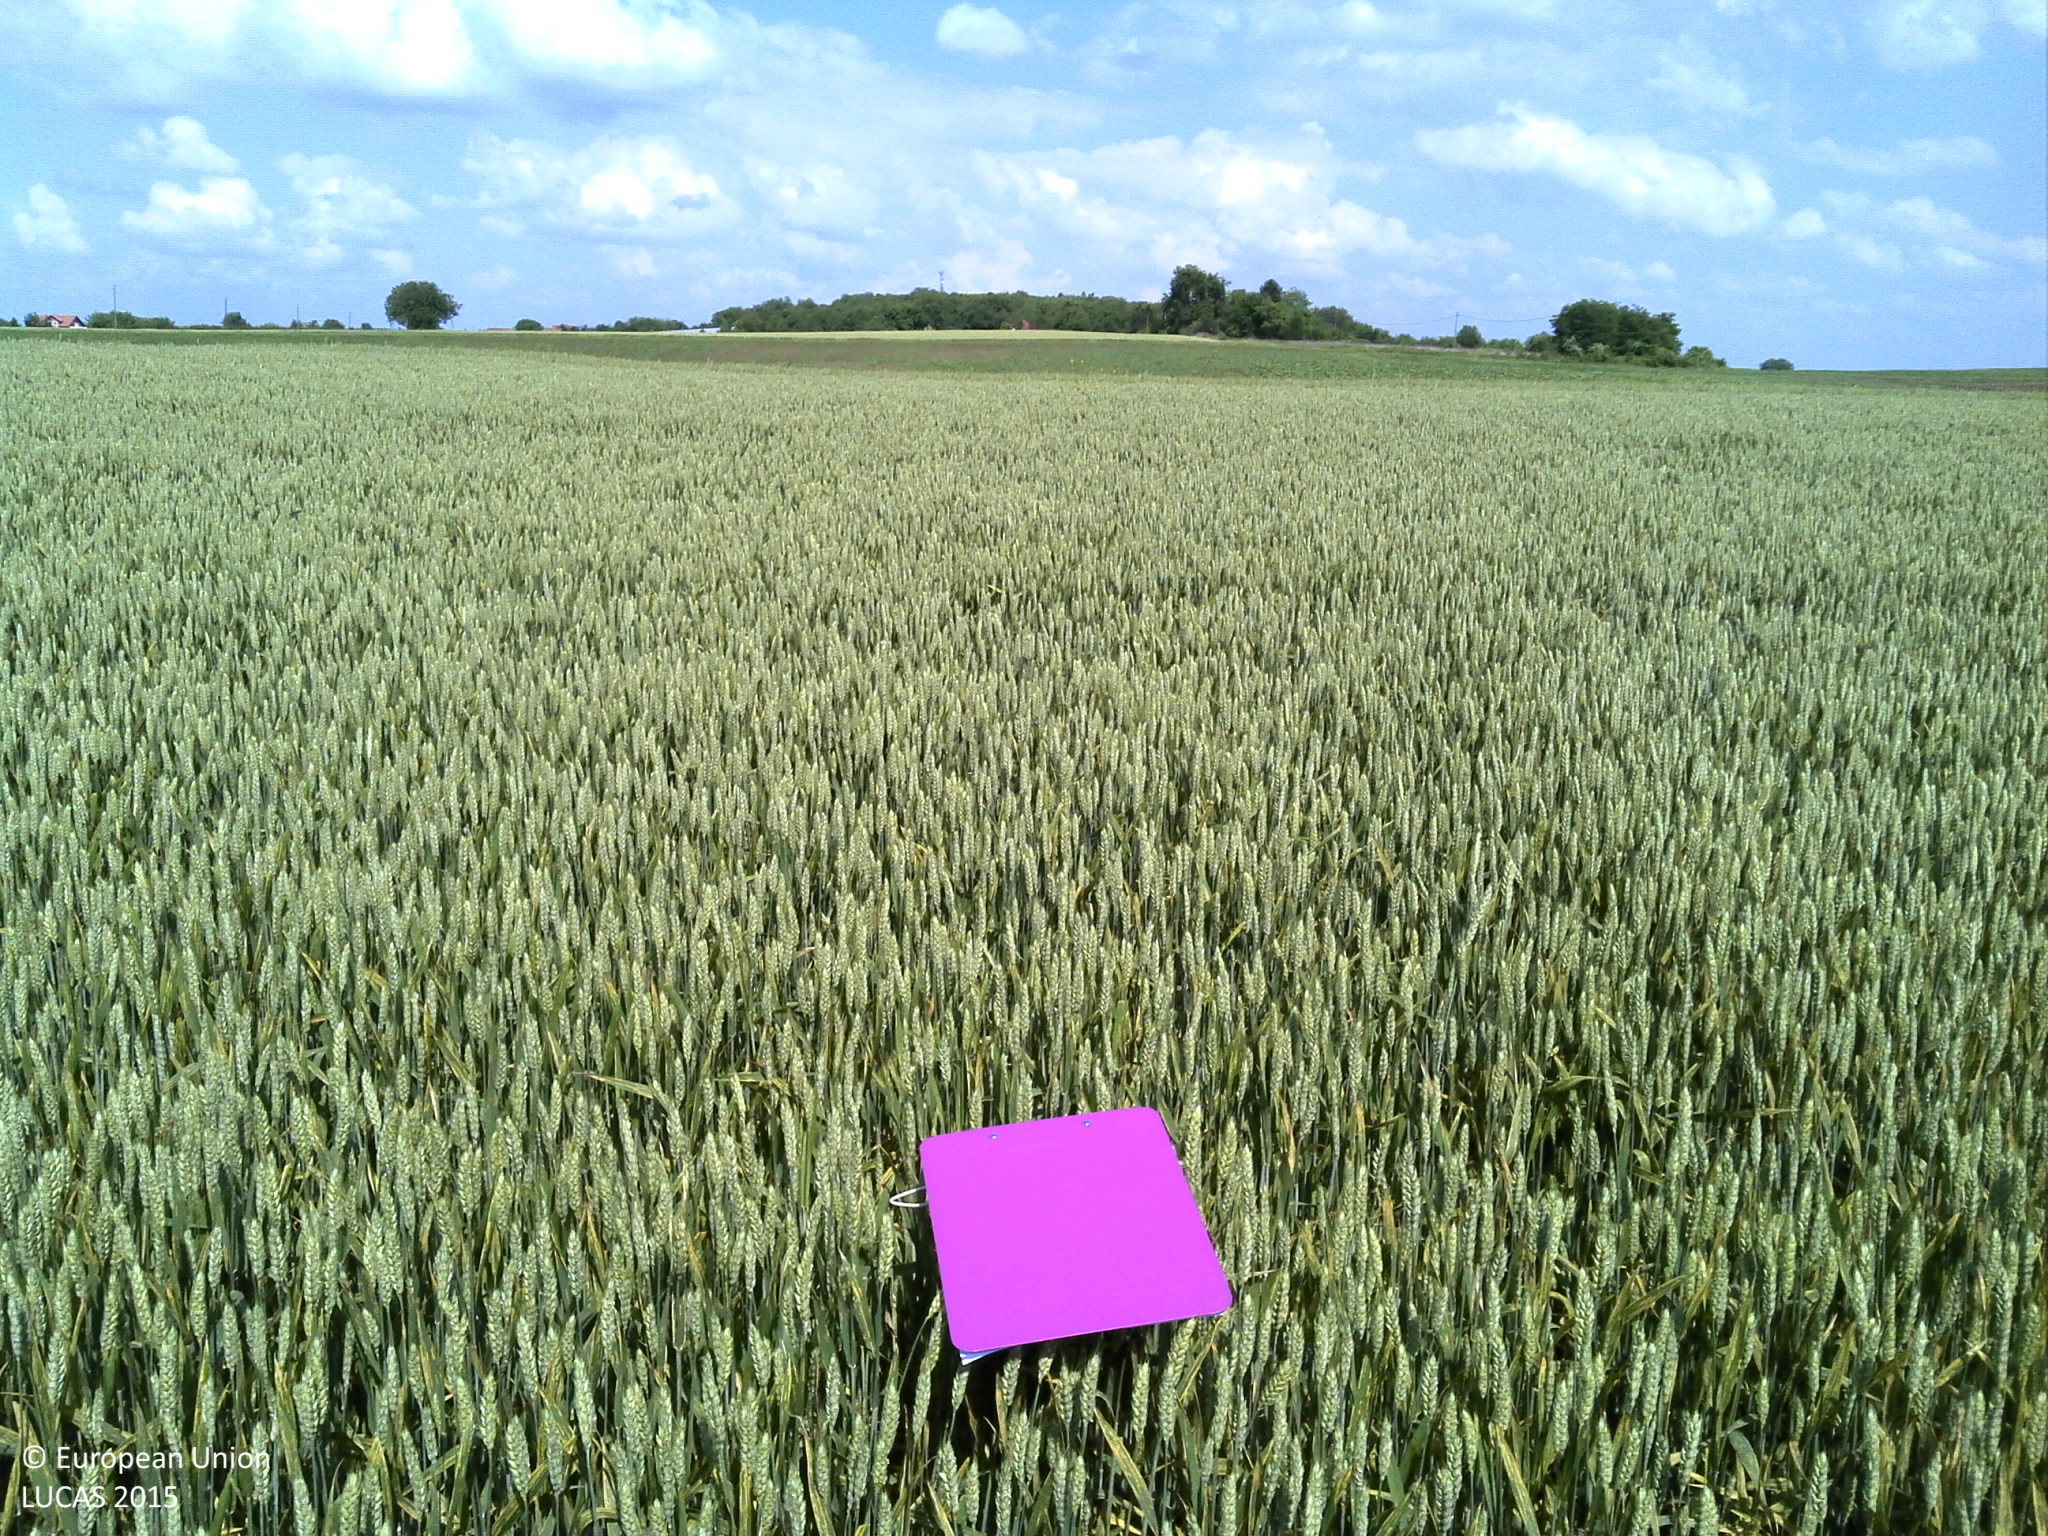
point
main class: Cropland
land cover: Common wheat
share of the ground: > 75 %
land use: Agriculture (excluding fallow land and kitchen gardens)
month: May
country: HR
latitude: 45.5217
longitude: 18.9583
